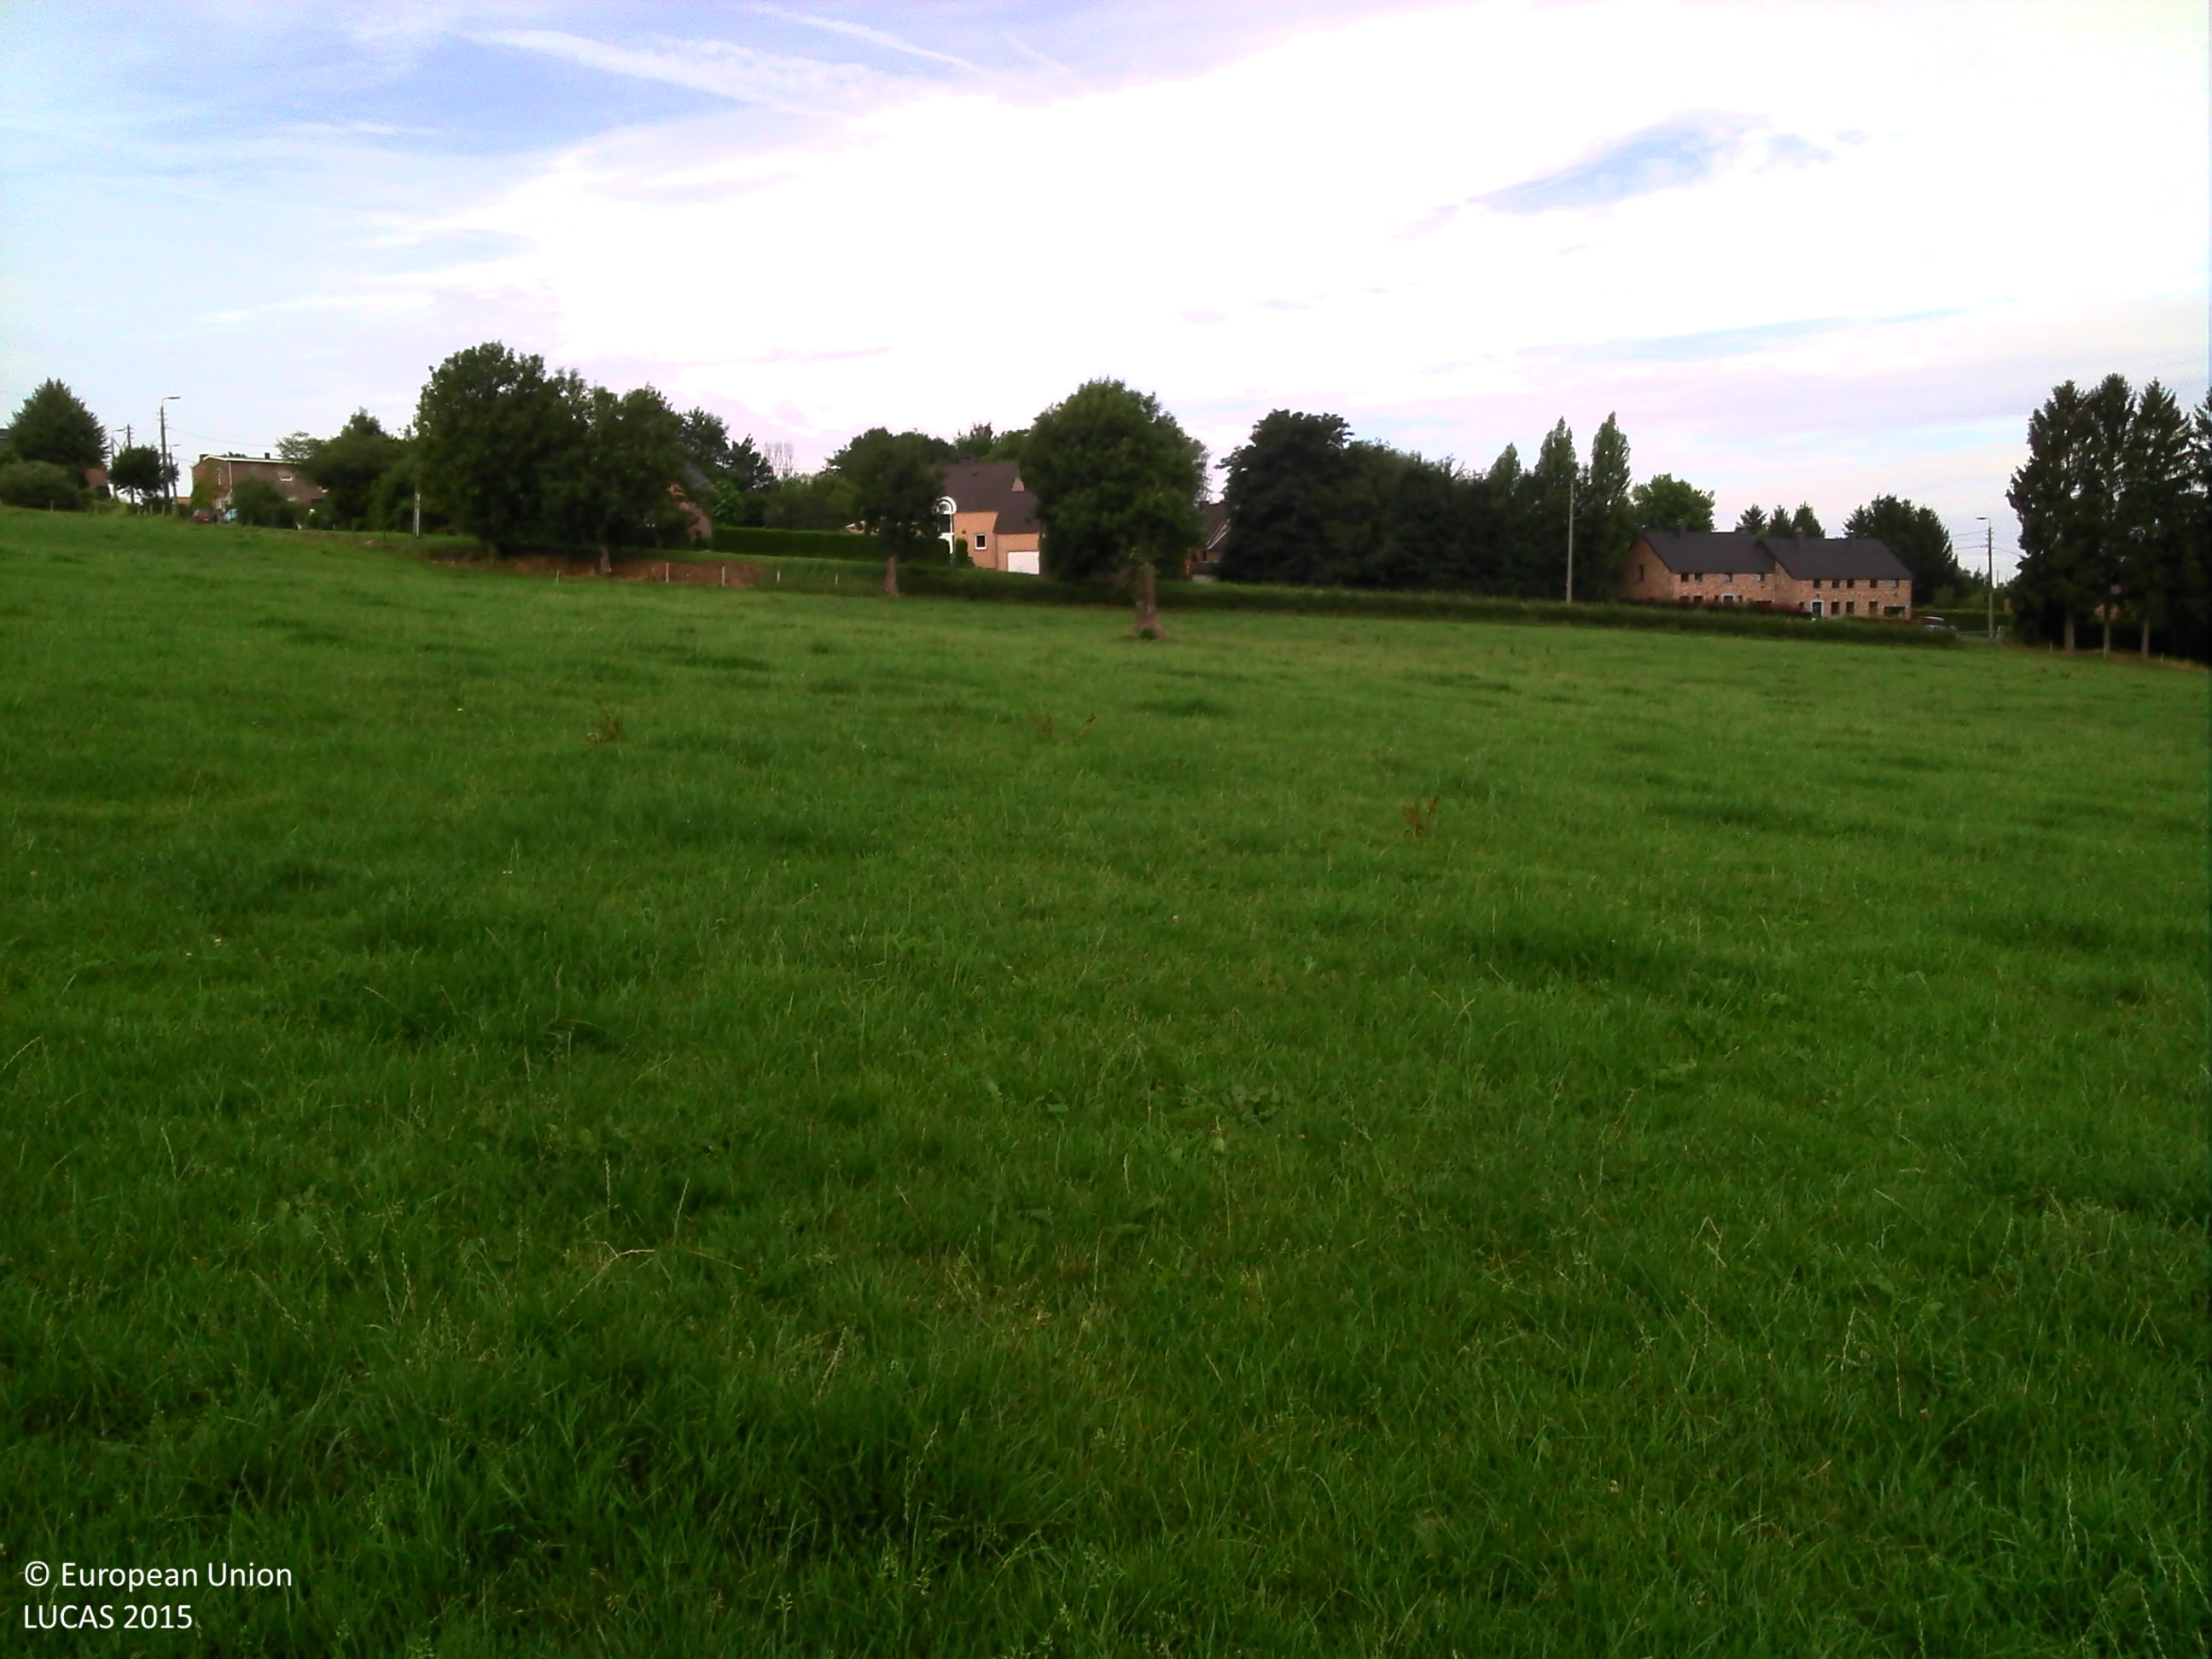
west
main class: Grassland
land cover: Grassland without tree/shrub cover
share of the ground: > 75 %
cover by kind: herbaceous plants 100 %
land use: Agriculture (excluding fallow land and kitchen gardens)
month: July
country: BE
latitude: 50.6449
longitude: 5.7419
